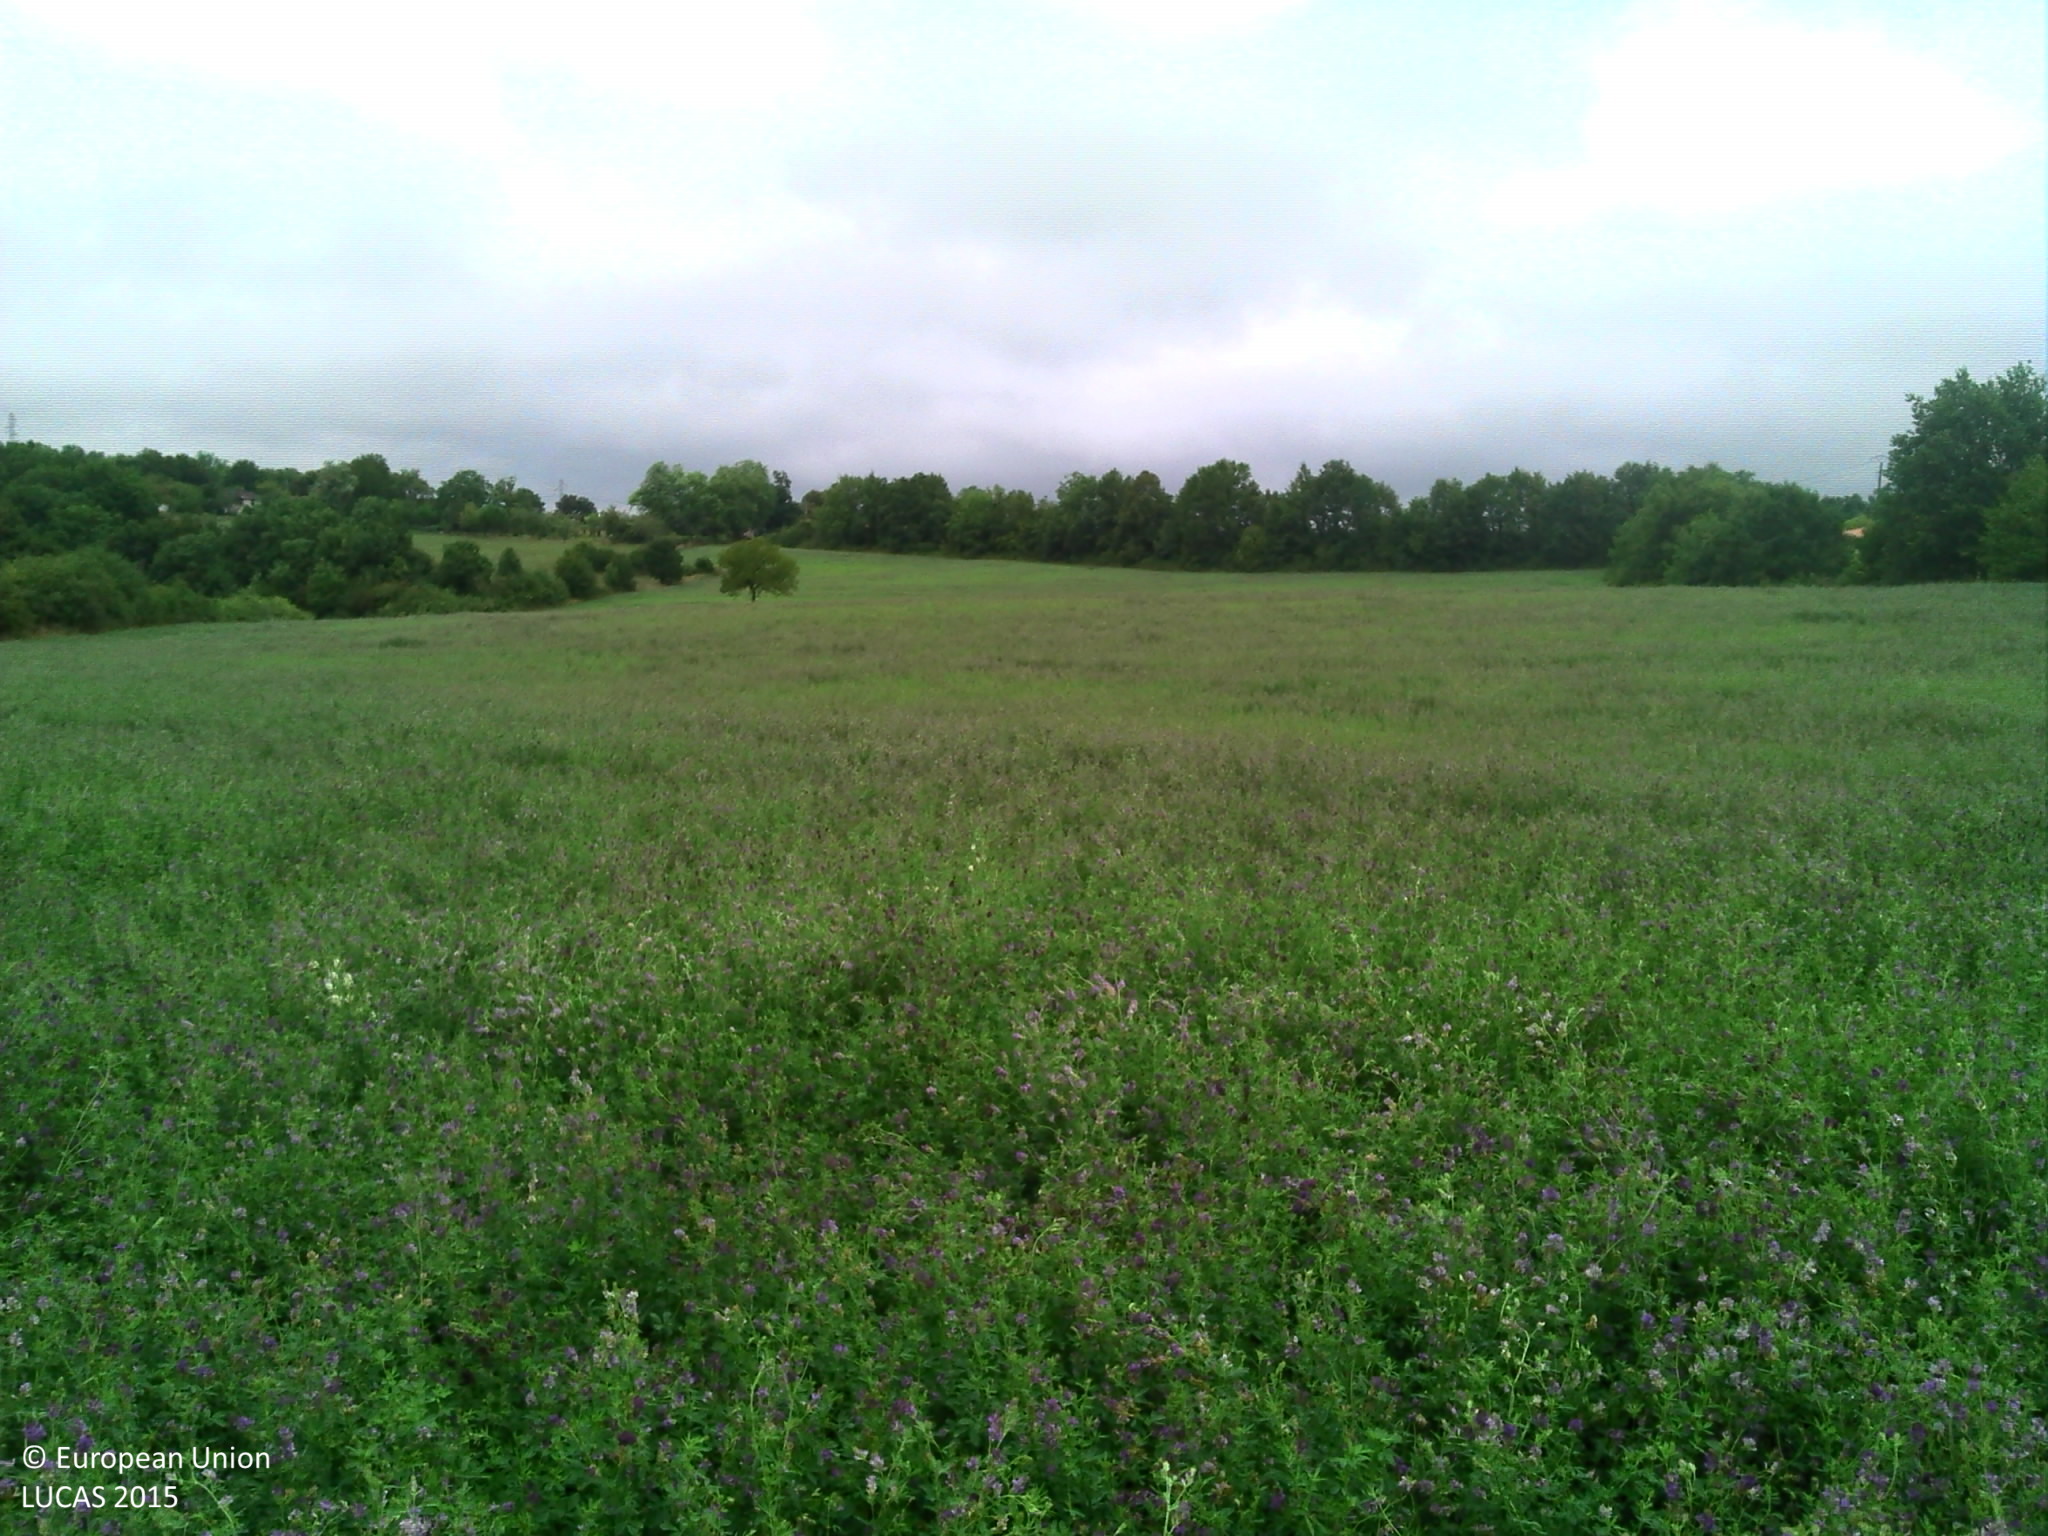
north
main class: Cropland
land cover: Lucerne
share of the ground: > 75 %
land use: Agriculture (excluding fallow land and kitchen gardens)
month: August
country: FR
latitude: 45.5064
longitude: 0.6576
